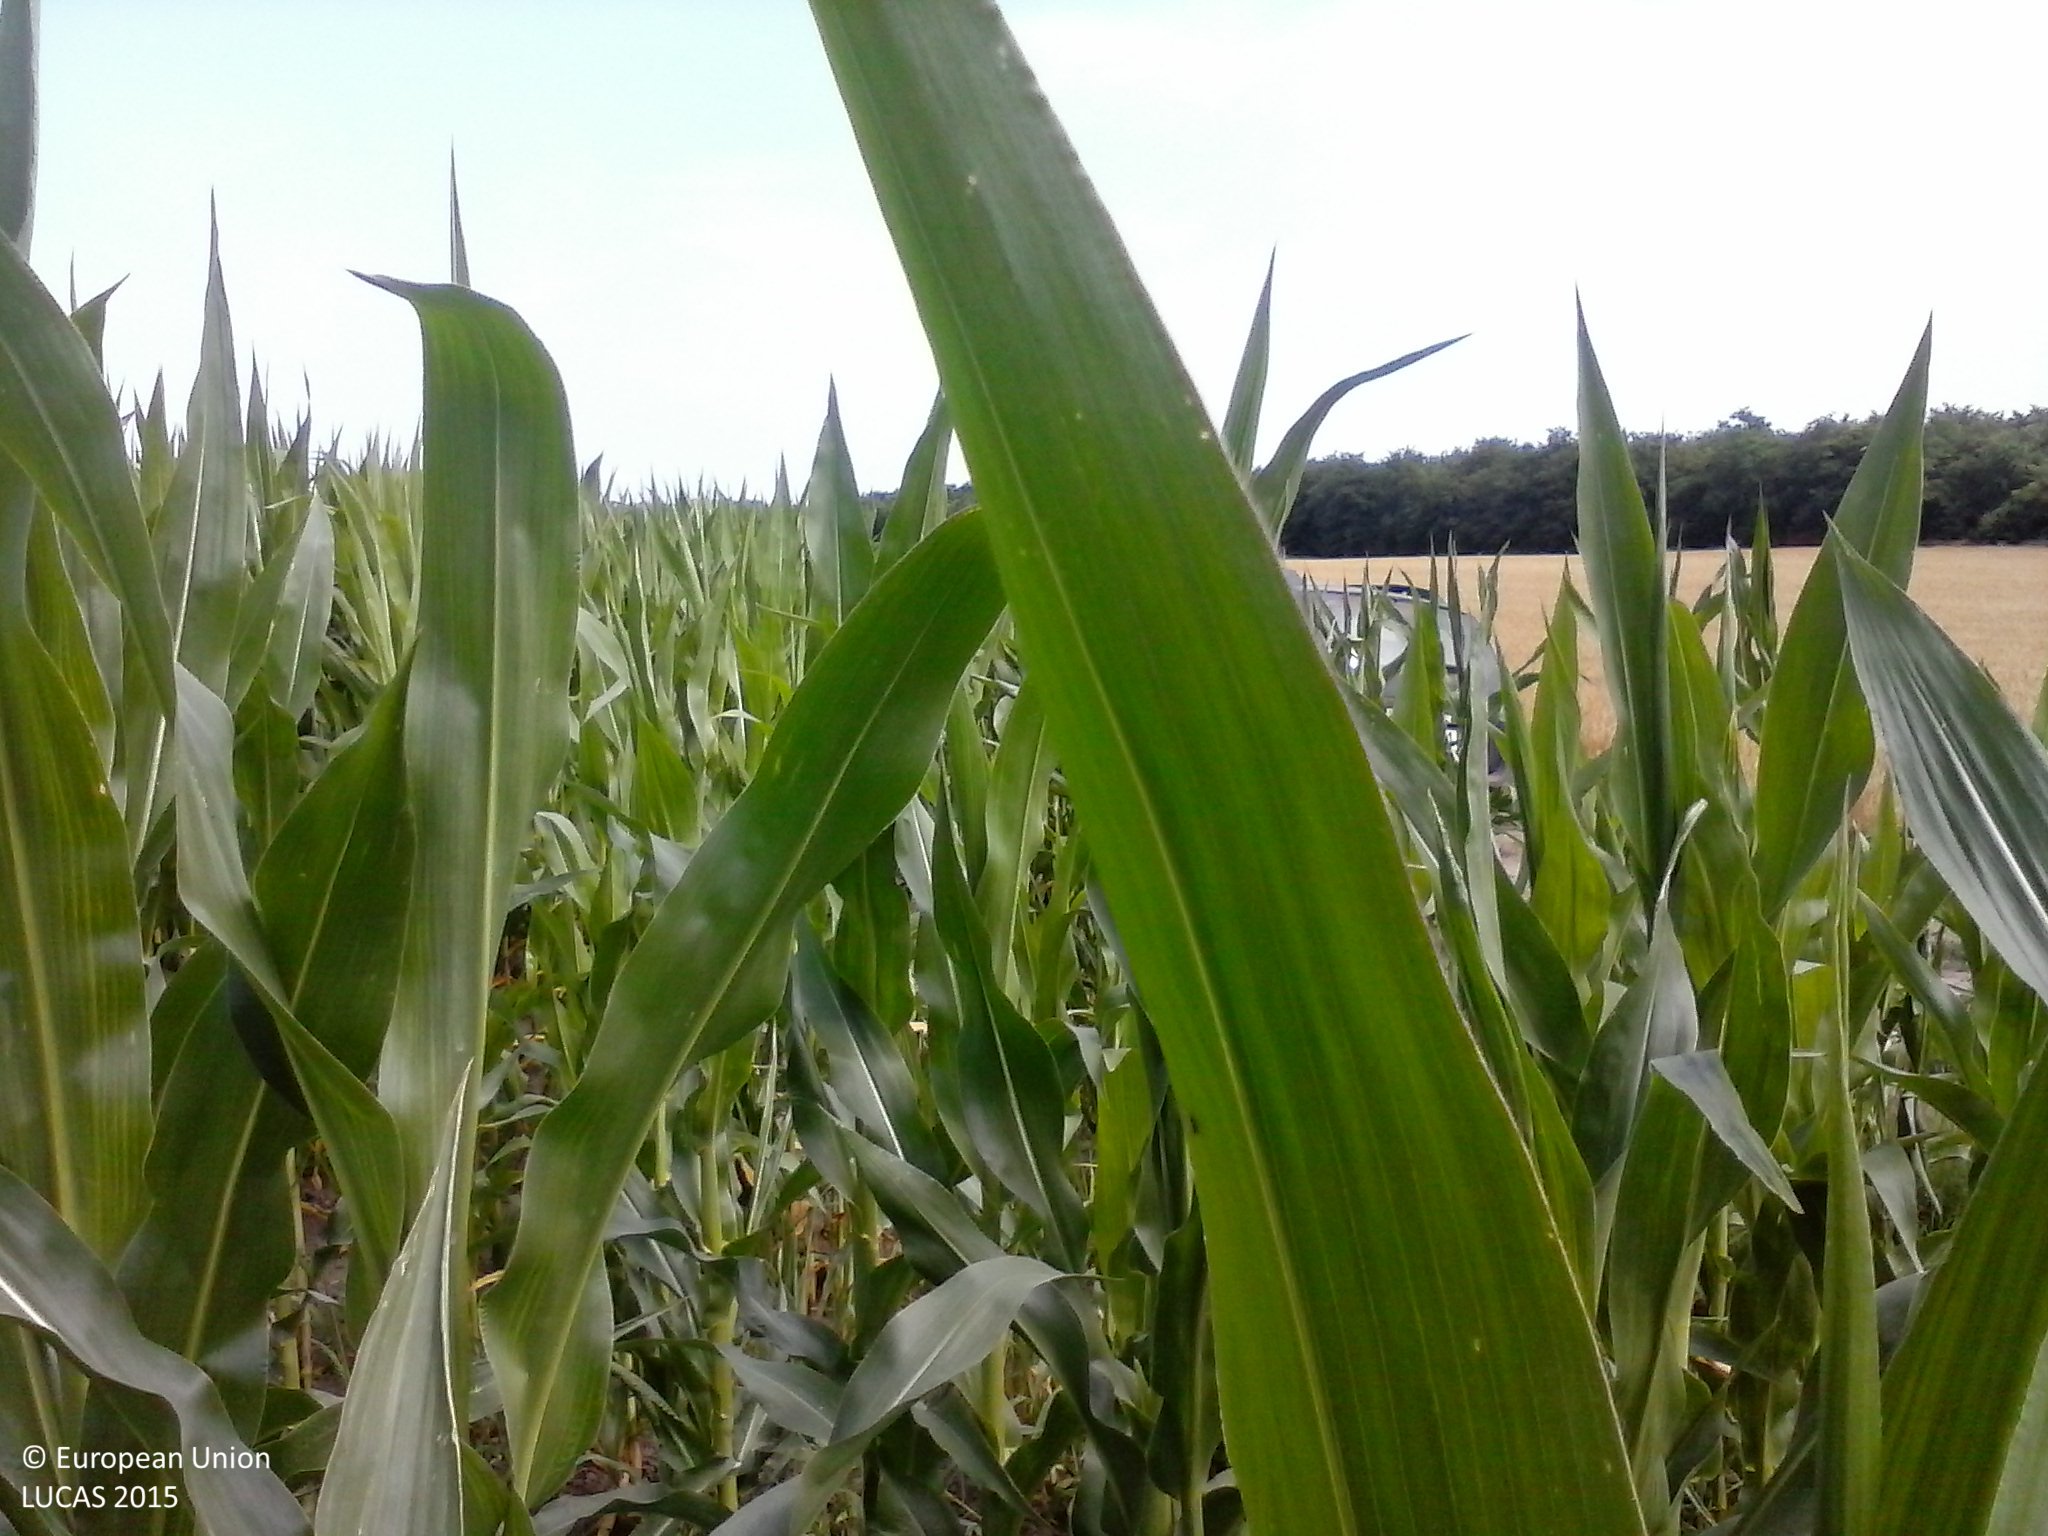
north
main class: Cropland
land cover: Maize
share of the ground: > 75 %
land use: Agriculture (excluding fallow land and kitchen gardens)
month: June
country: HU
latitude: 46.1981
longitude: 19.5150
